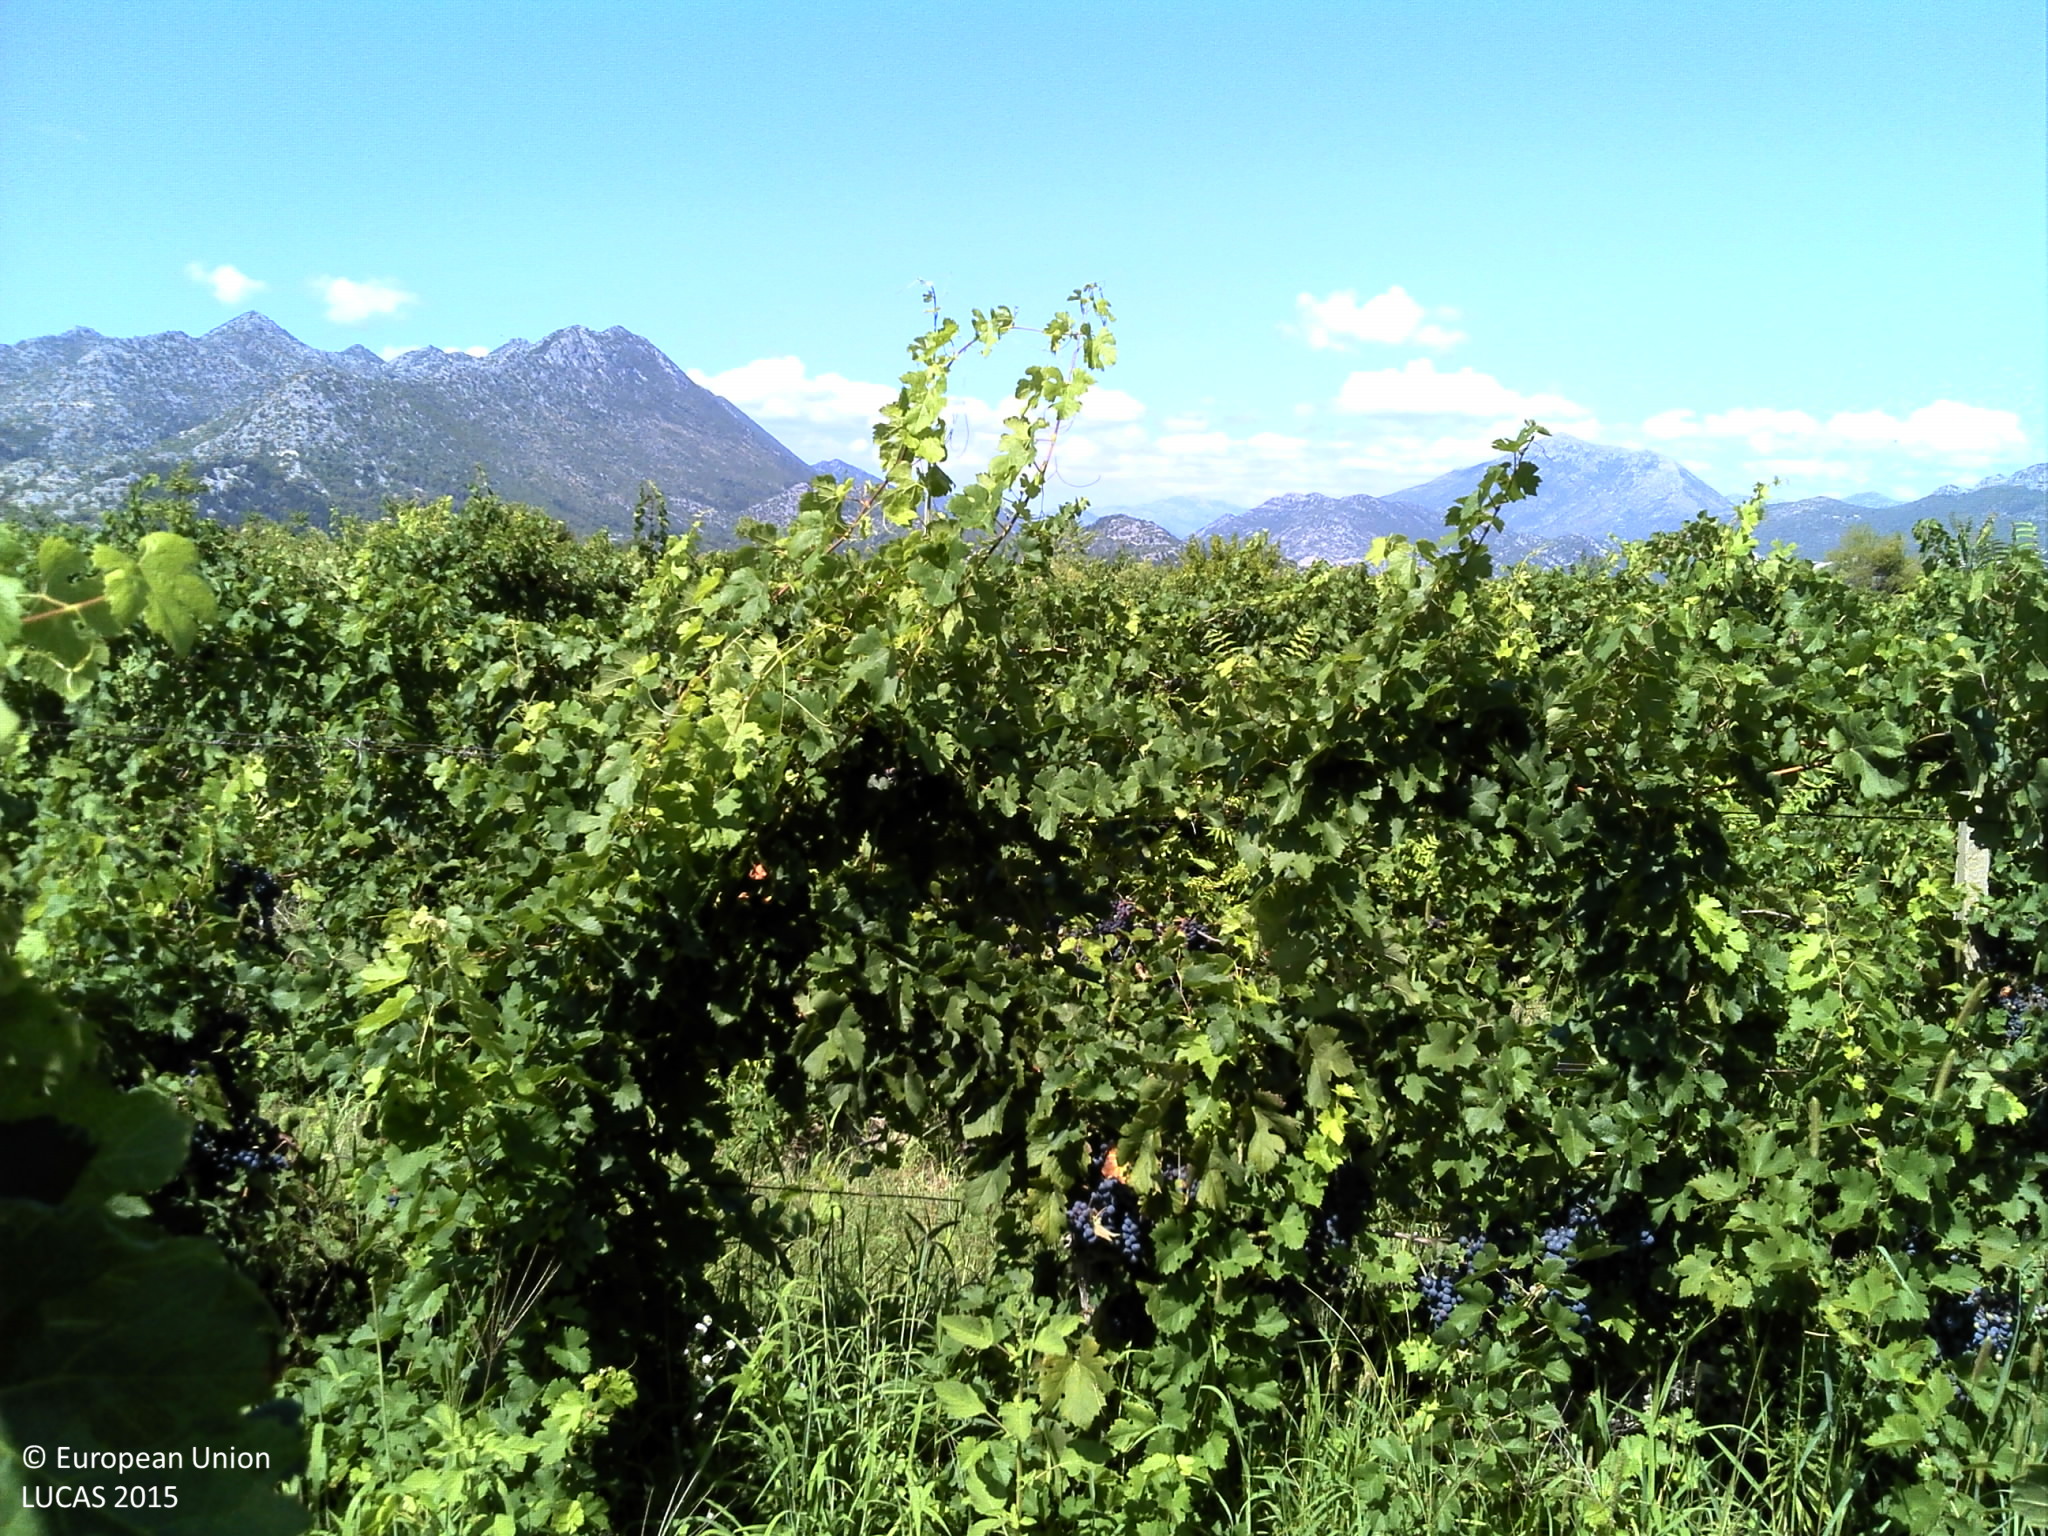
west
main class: Cropland
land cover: Vineyards
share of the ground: 50 - 75 %
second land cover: Grassland without tree/shrub cover
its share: > 75 %
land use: Agriculture (excluding fallow land and kitchen gardens)
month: August
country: HR
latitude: 43.1404
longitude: 17.4539
